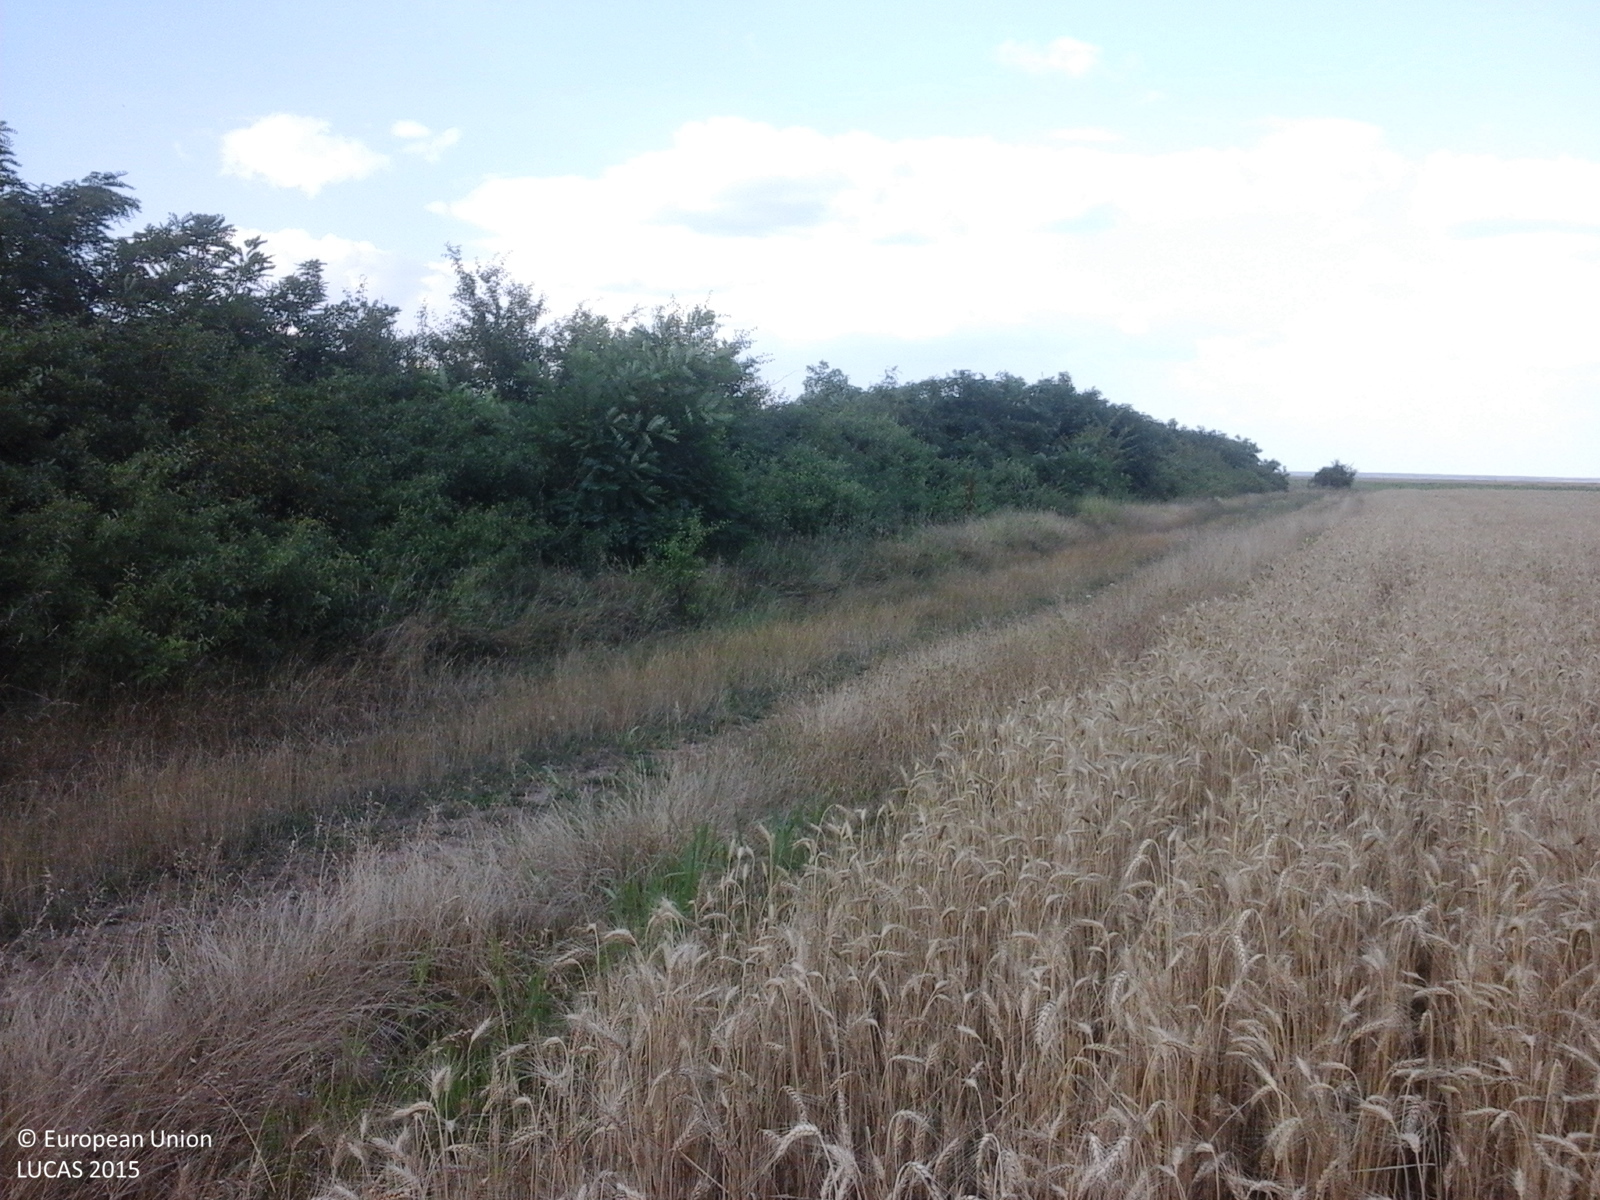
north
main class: Cropland
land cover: Common wheat
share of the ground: > 75 %
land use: Agriculture (excluding fallow land and kitchen gardens)
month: July
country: RO
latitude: 44.2093
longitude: 25.8276
